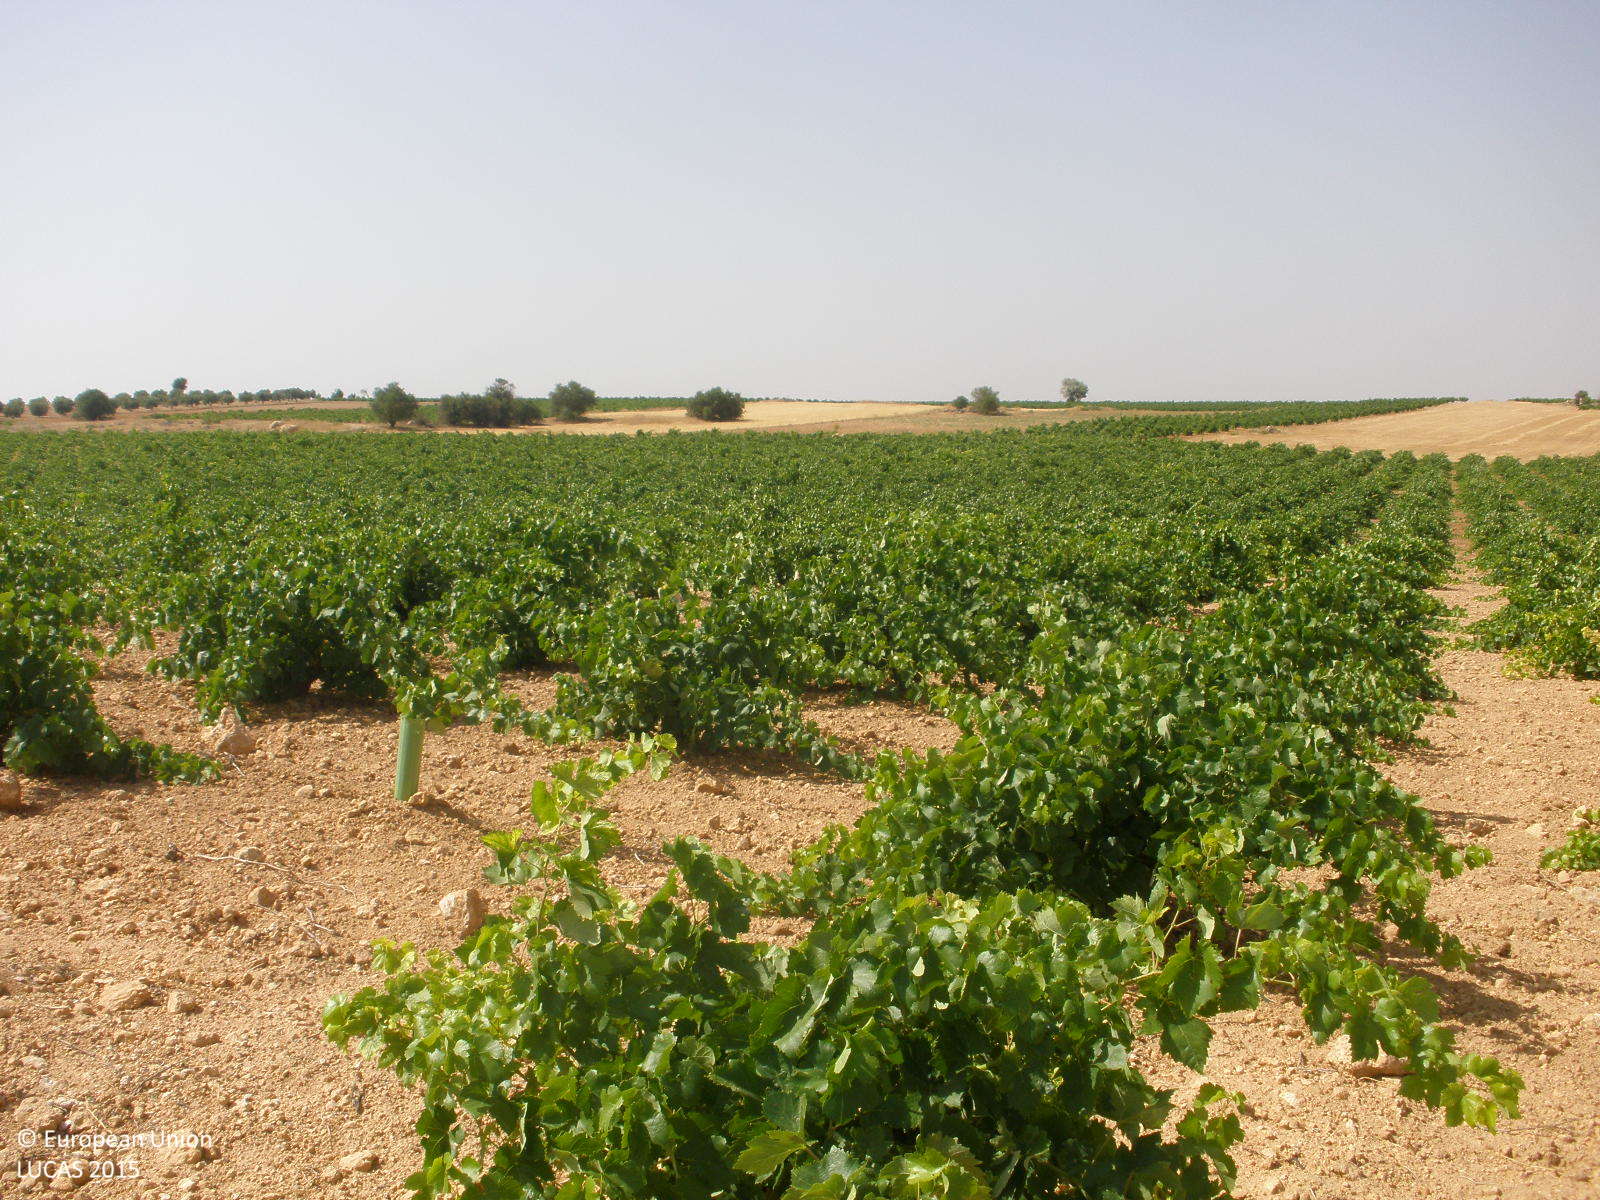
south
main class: Cropland
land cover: Vineyards
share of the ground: 50 - 75 %
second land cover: Other bare soil
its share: > 75 %
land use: Agriculture (excluding fallow land and kitchen gardens)
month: July
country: ES
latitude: 39.7294
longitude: -3.1239
